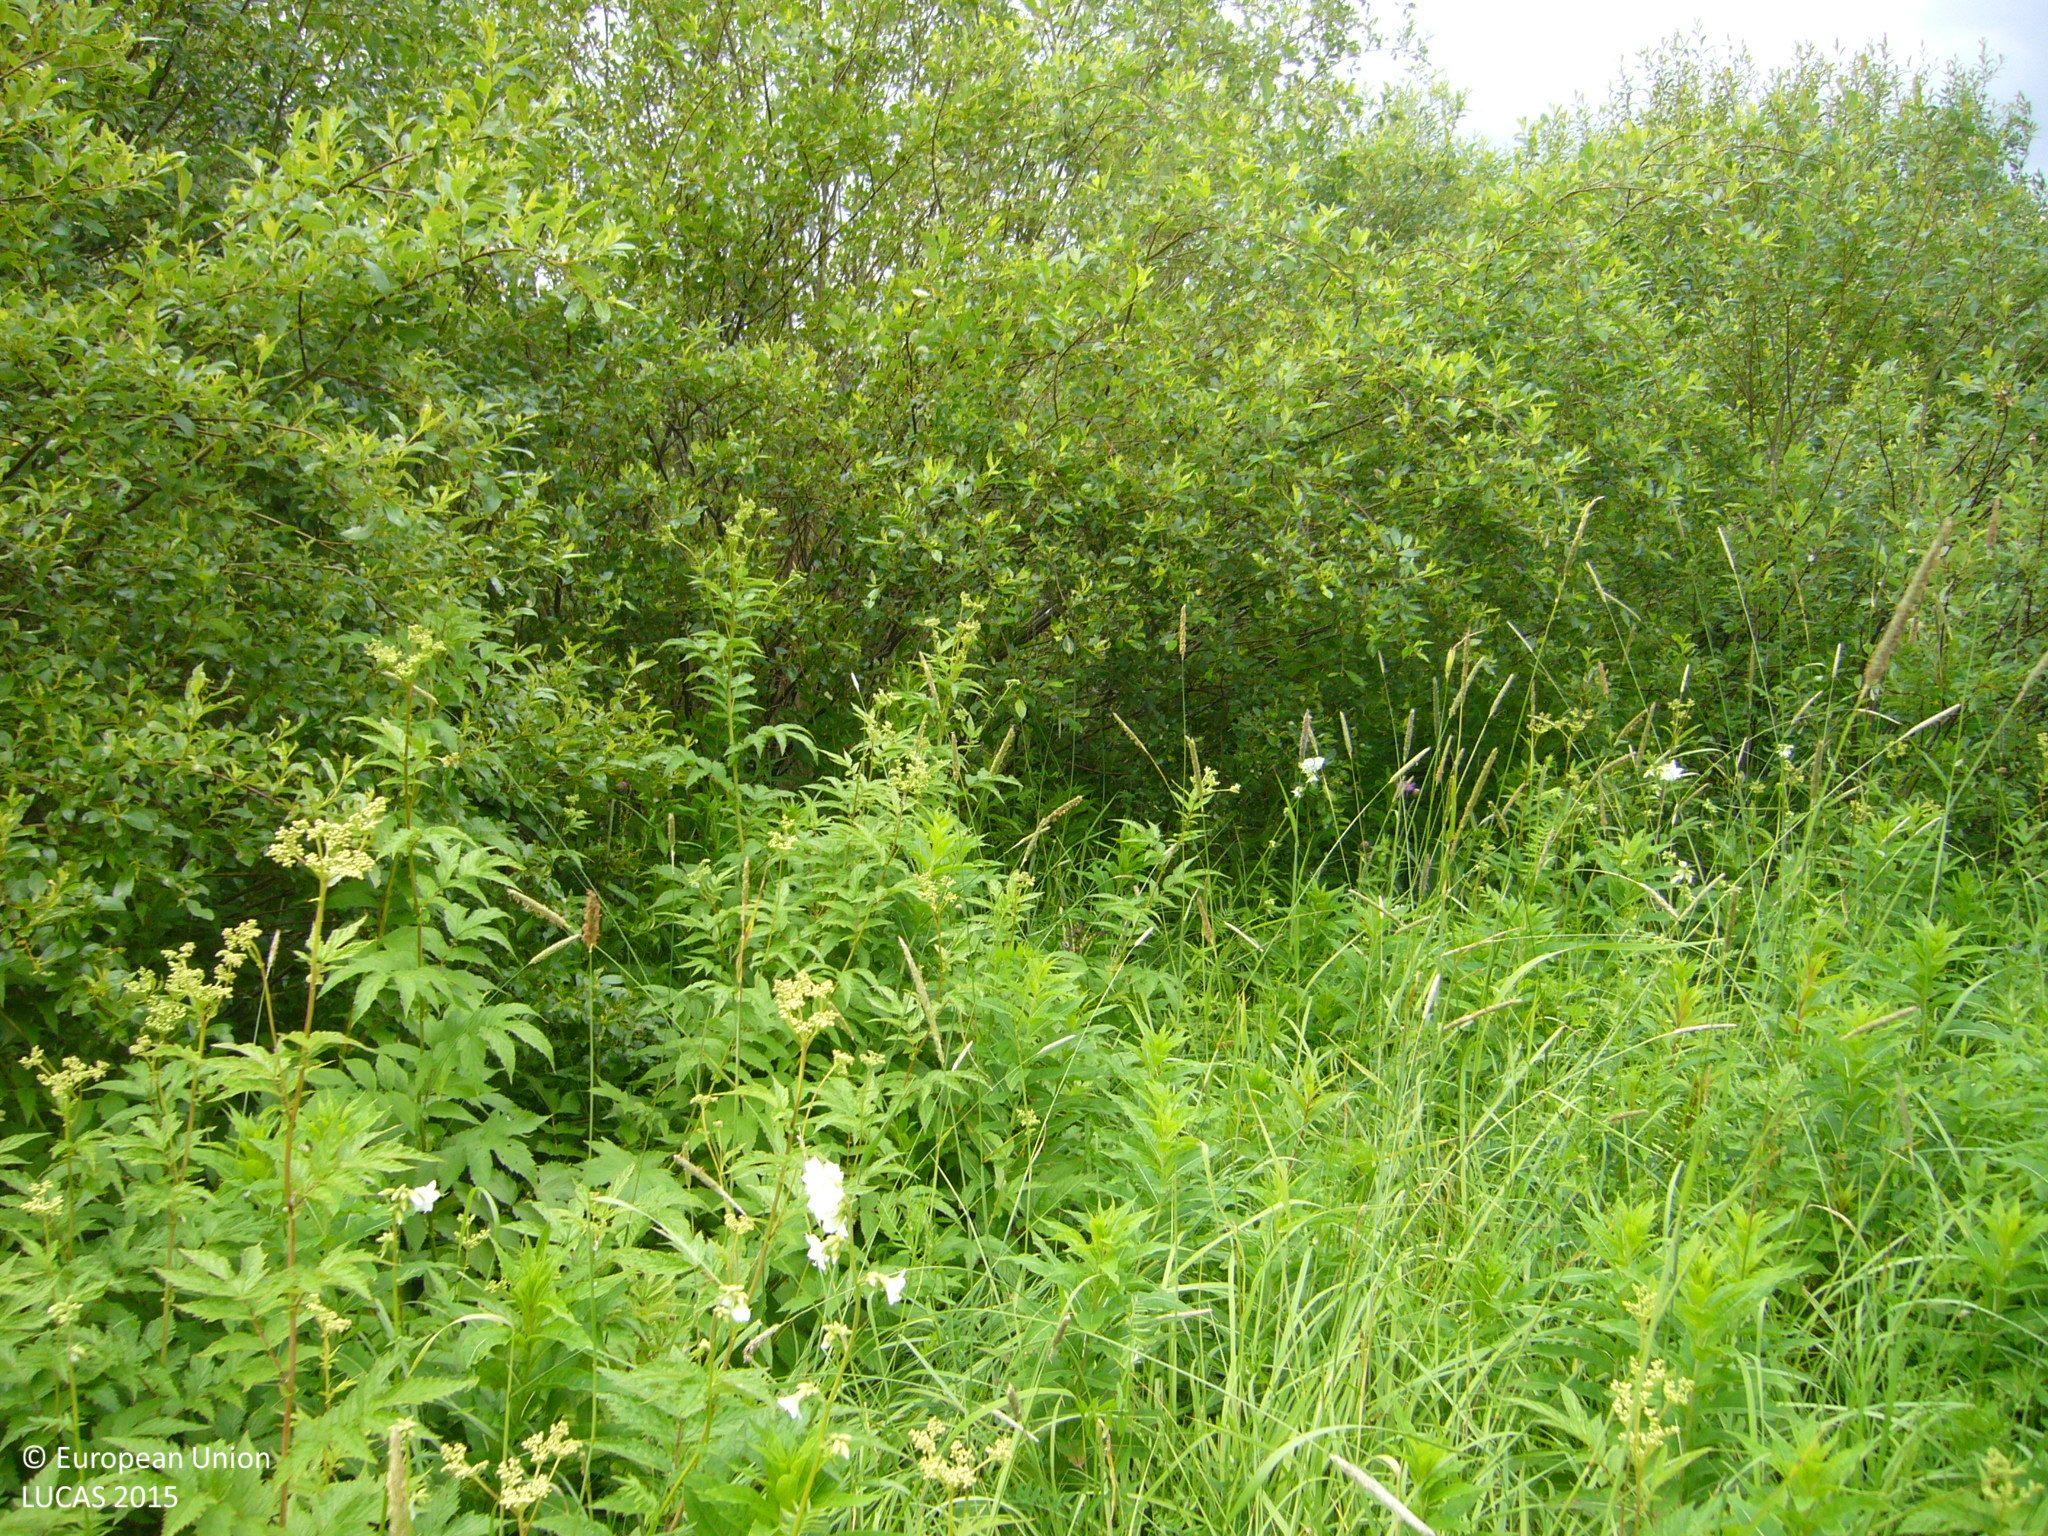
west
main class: Grassland
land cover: Spontaneously vegetated surfaces
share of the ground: > 75 %
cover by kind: herbaceous plants 100 %
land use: Fallow land
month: July
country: FI
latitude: 63.7606
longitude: 25.4851
